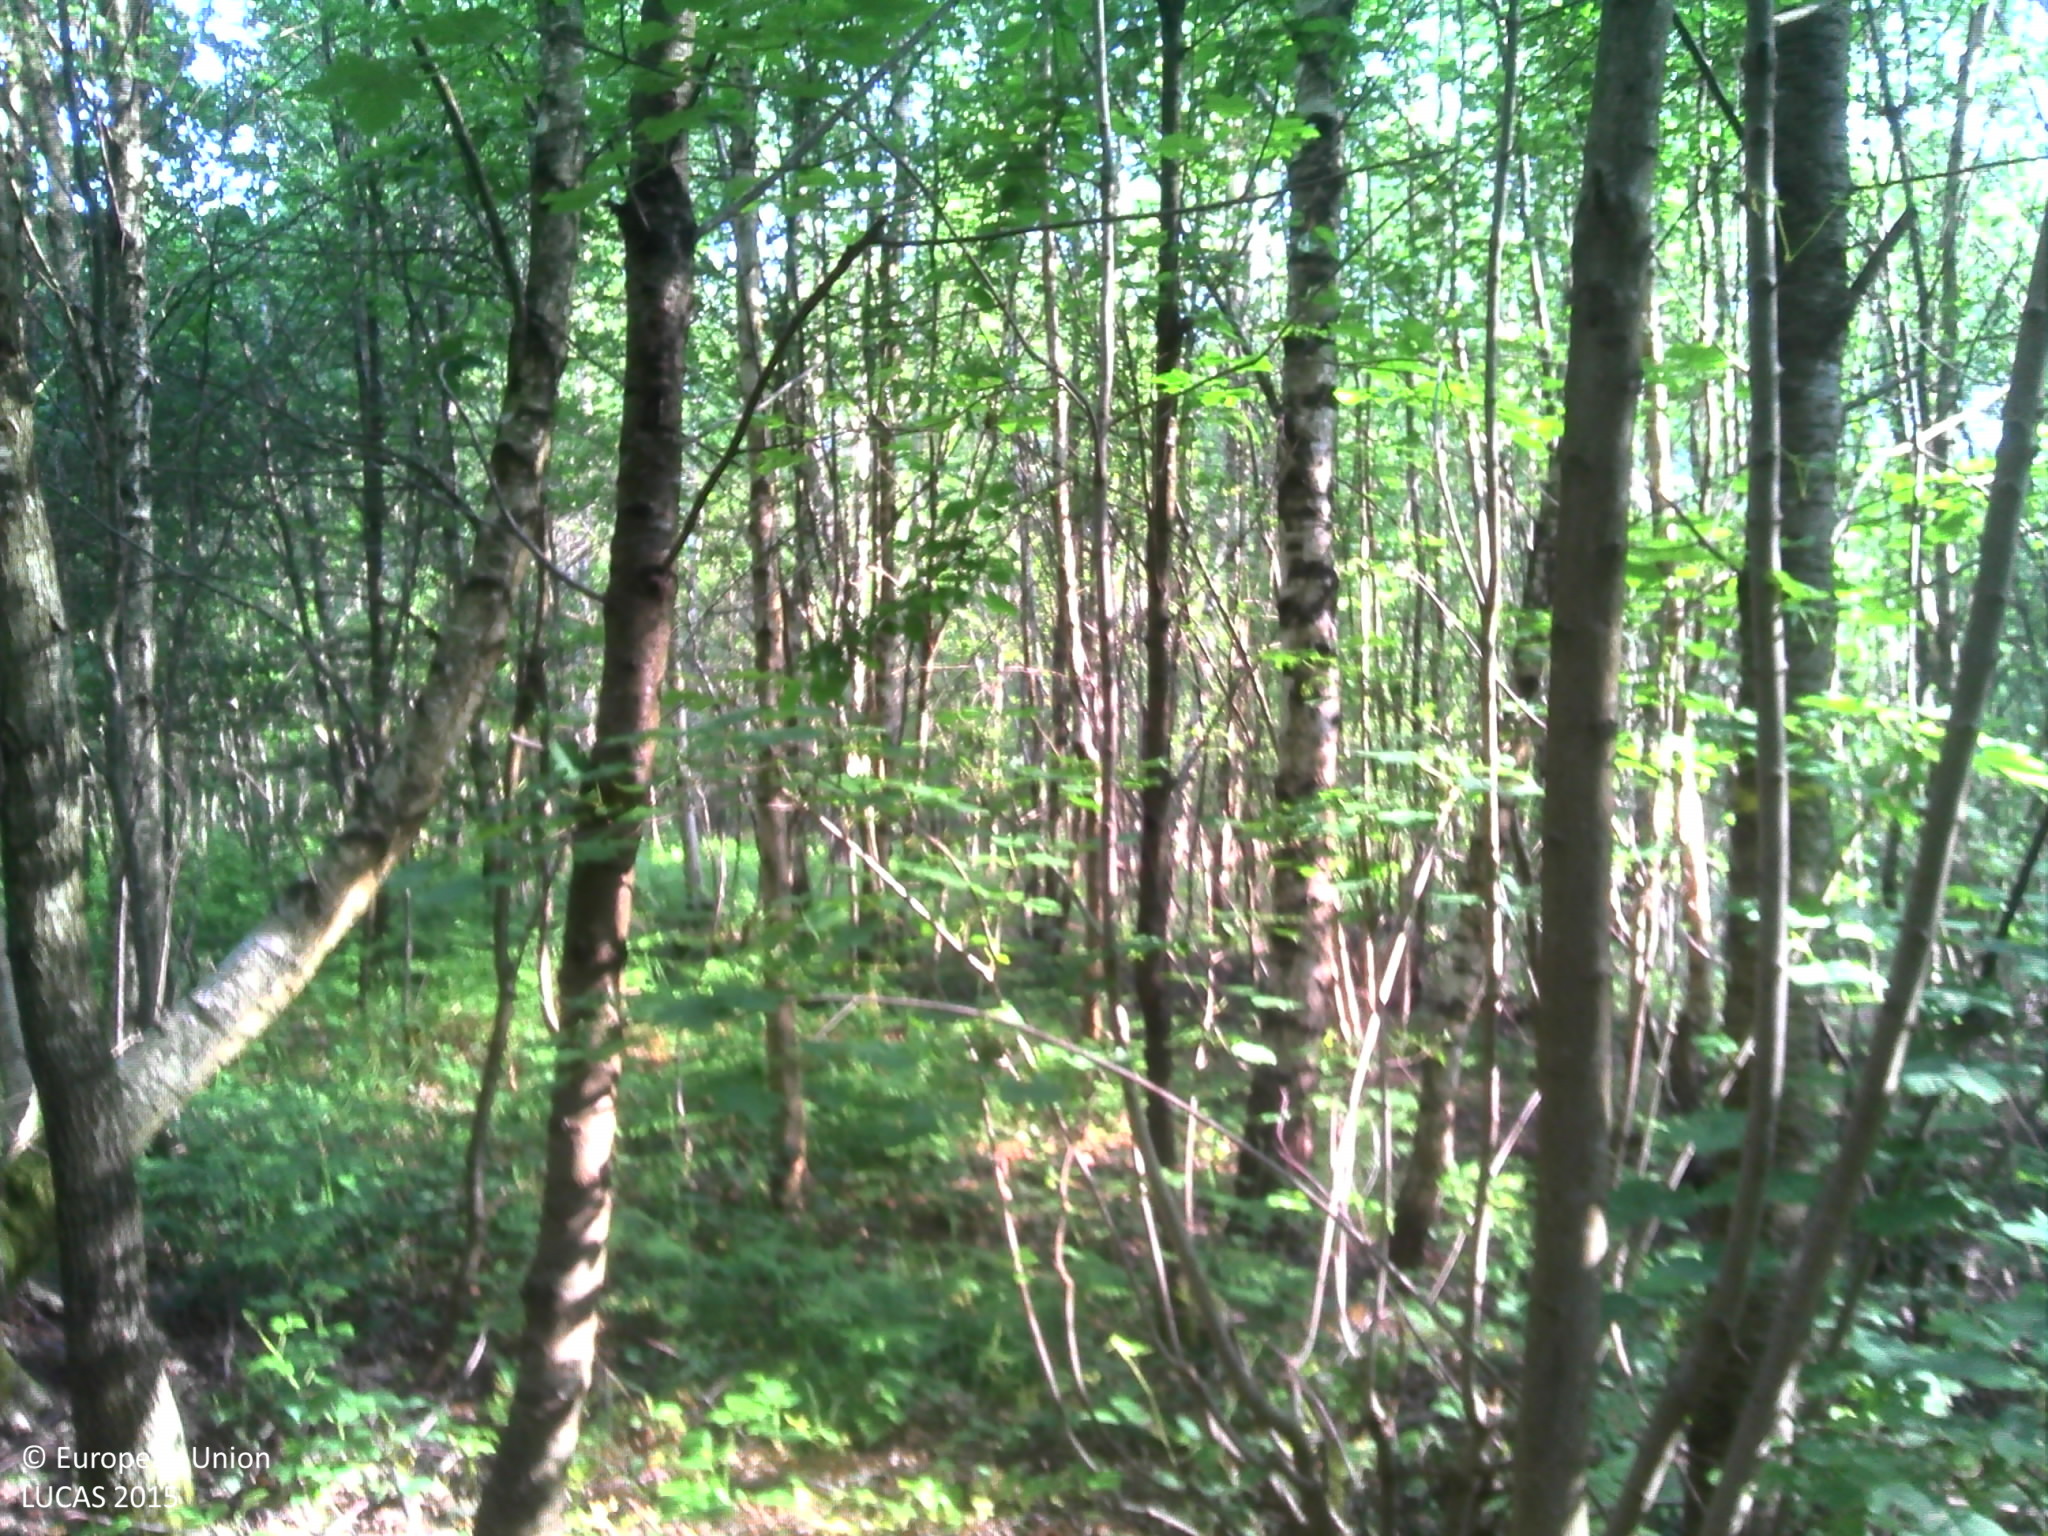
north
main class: Woodland
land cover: Broadleaved woodland
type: acidophilous oak and oak-birch forest
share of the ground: > 75 %
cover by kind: broadleaved forest trees 100 %
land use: Forestry
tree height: > 5 m
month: June
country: BE
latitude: 50.0366
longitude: 4.5650
